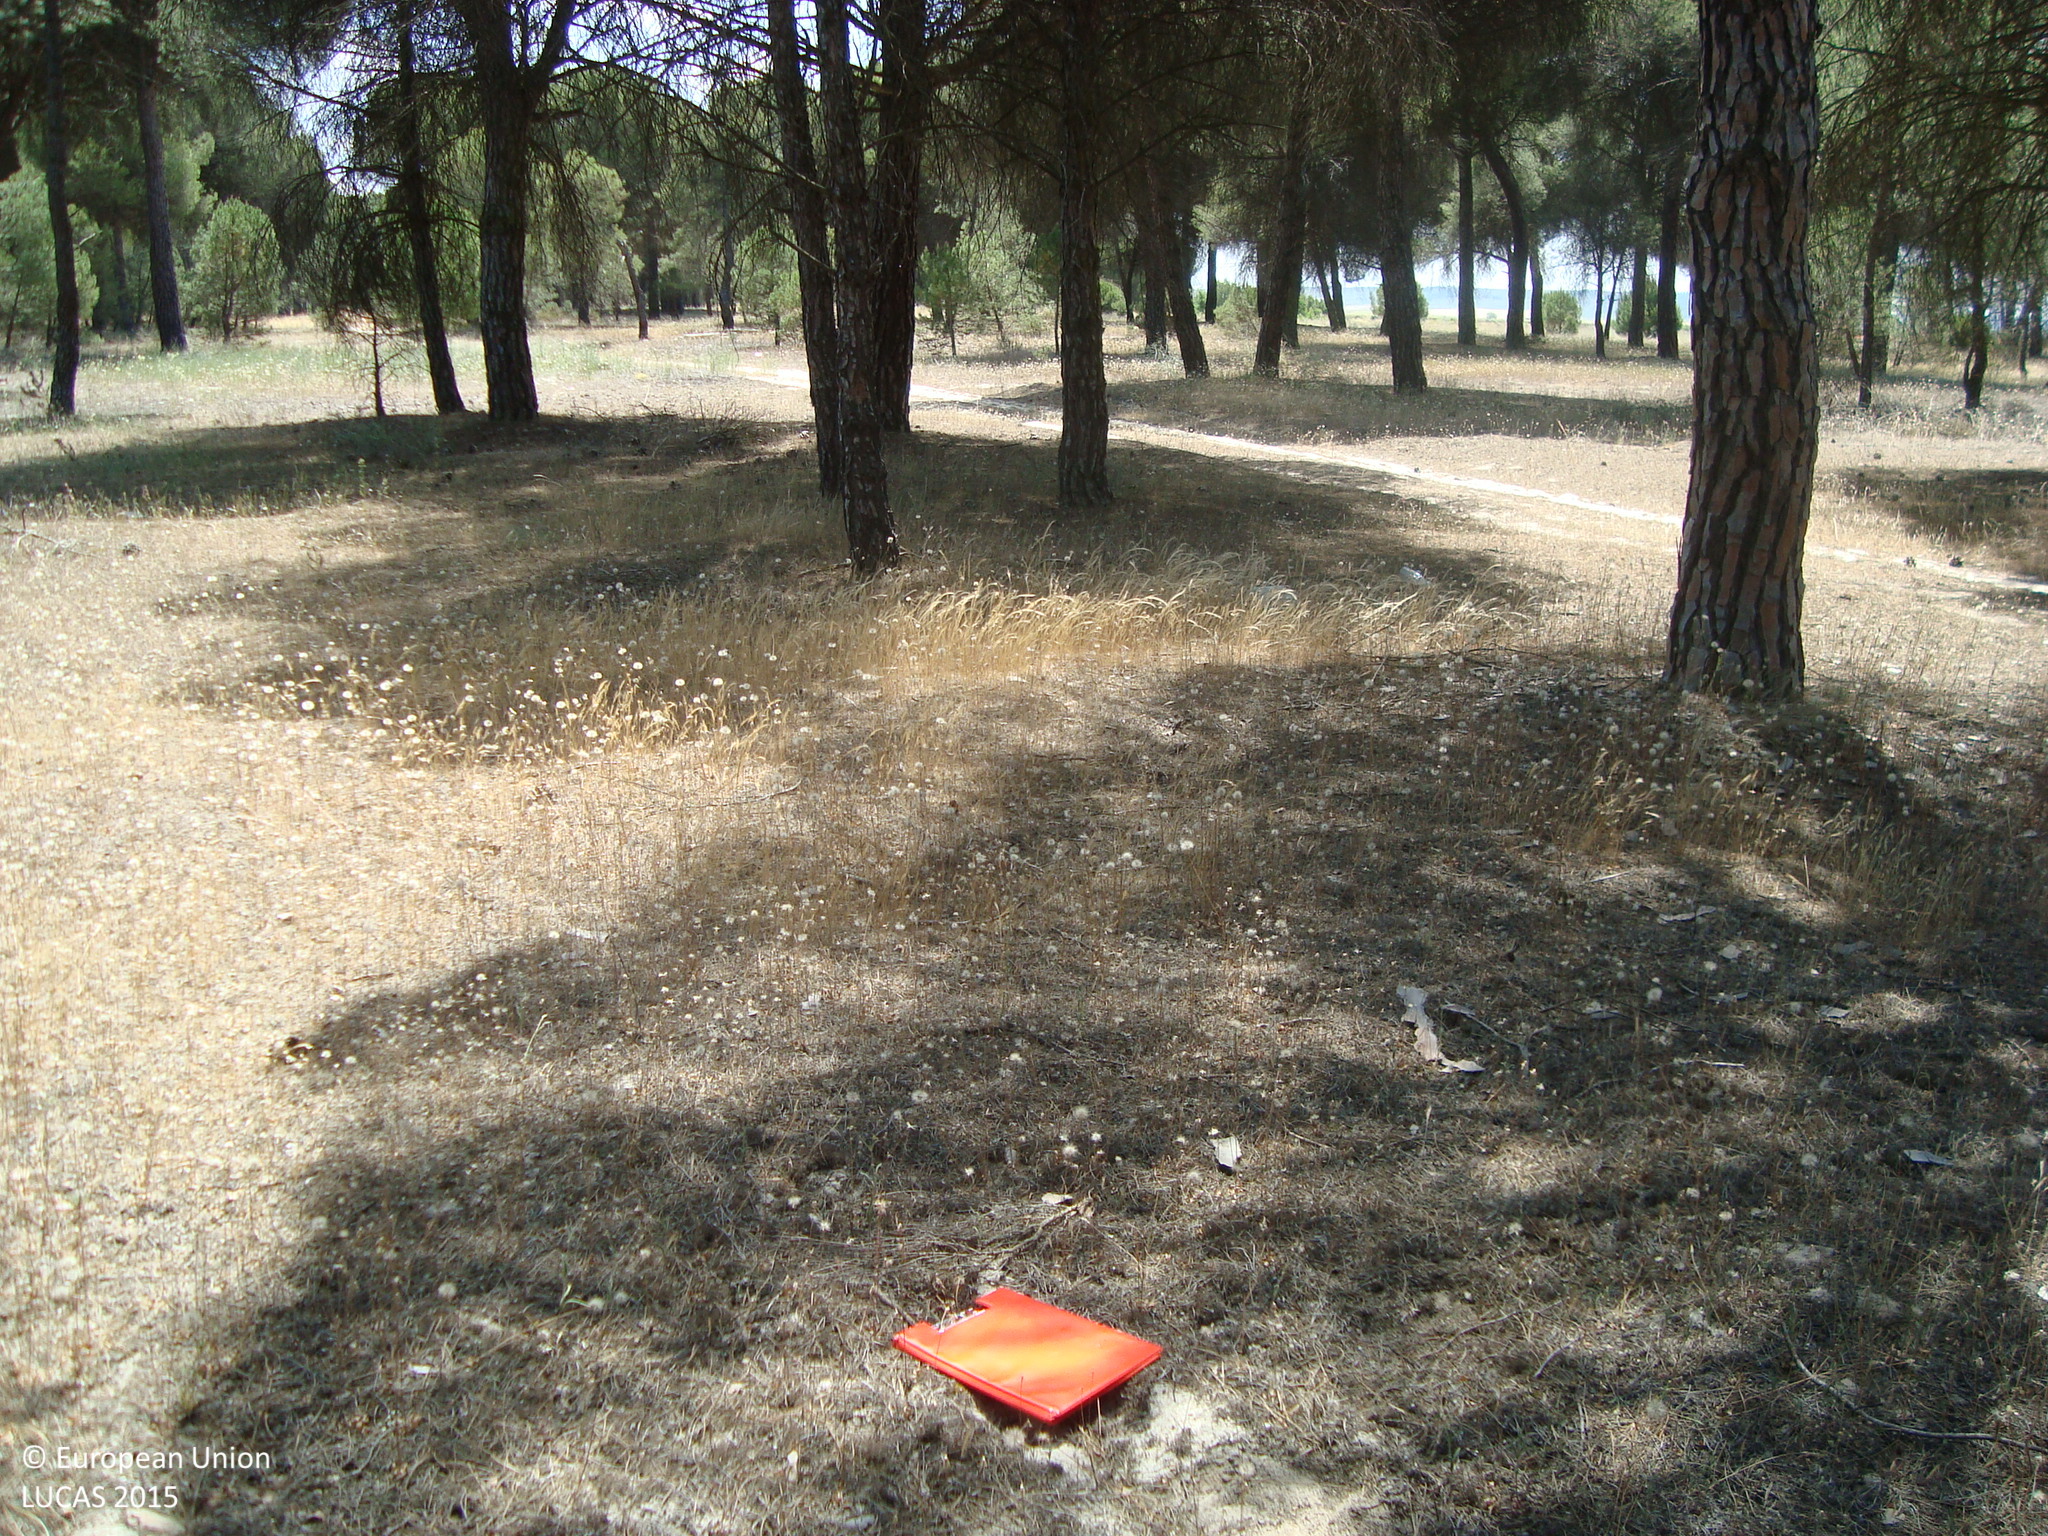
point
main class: Woodland
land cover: Pine dominated coniferous woodland
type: coniferous forest of the mediterranean region
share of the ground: 50 - 75 %
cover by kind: coniferous forest trees 60 %, herbaceous plants 30 %, unconsolidated bare surface 10 %
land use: Forestry
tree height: > 5 m
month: June
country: ES
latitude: 41.4916
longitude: -4.6428
